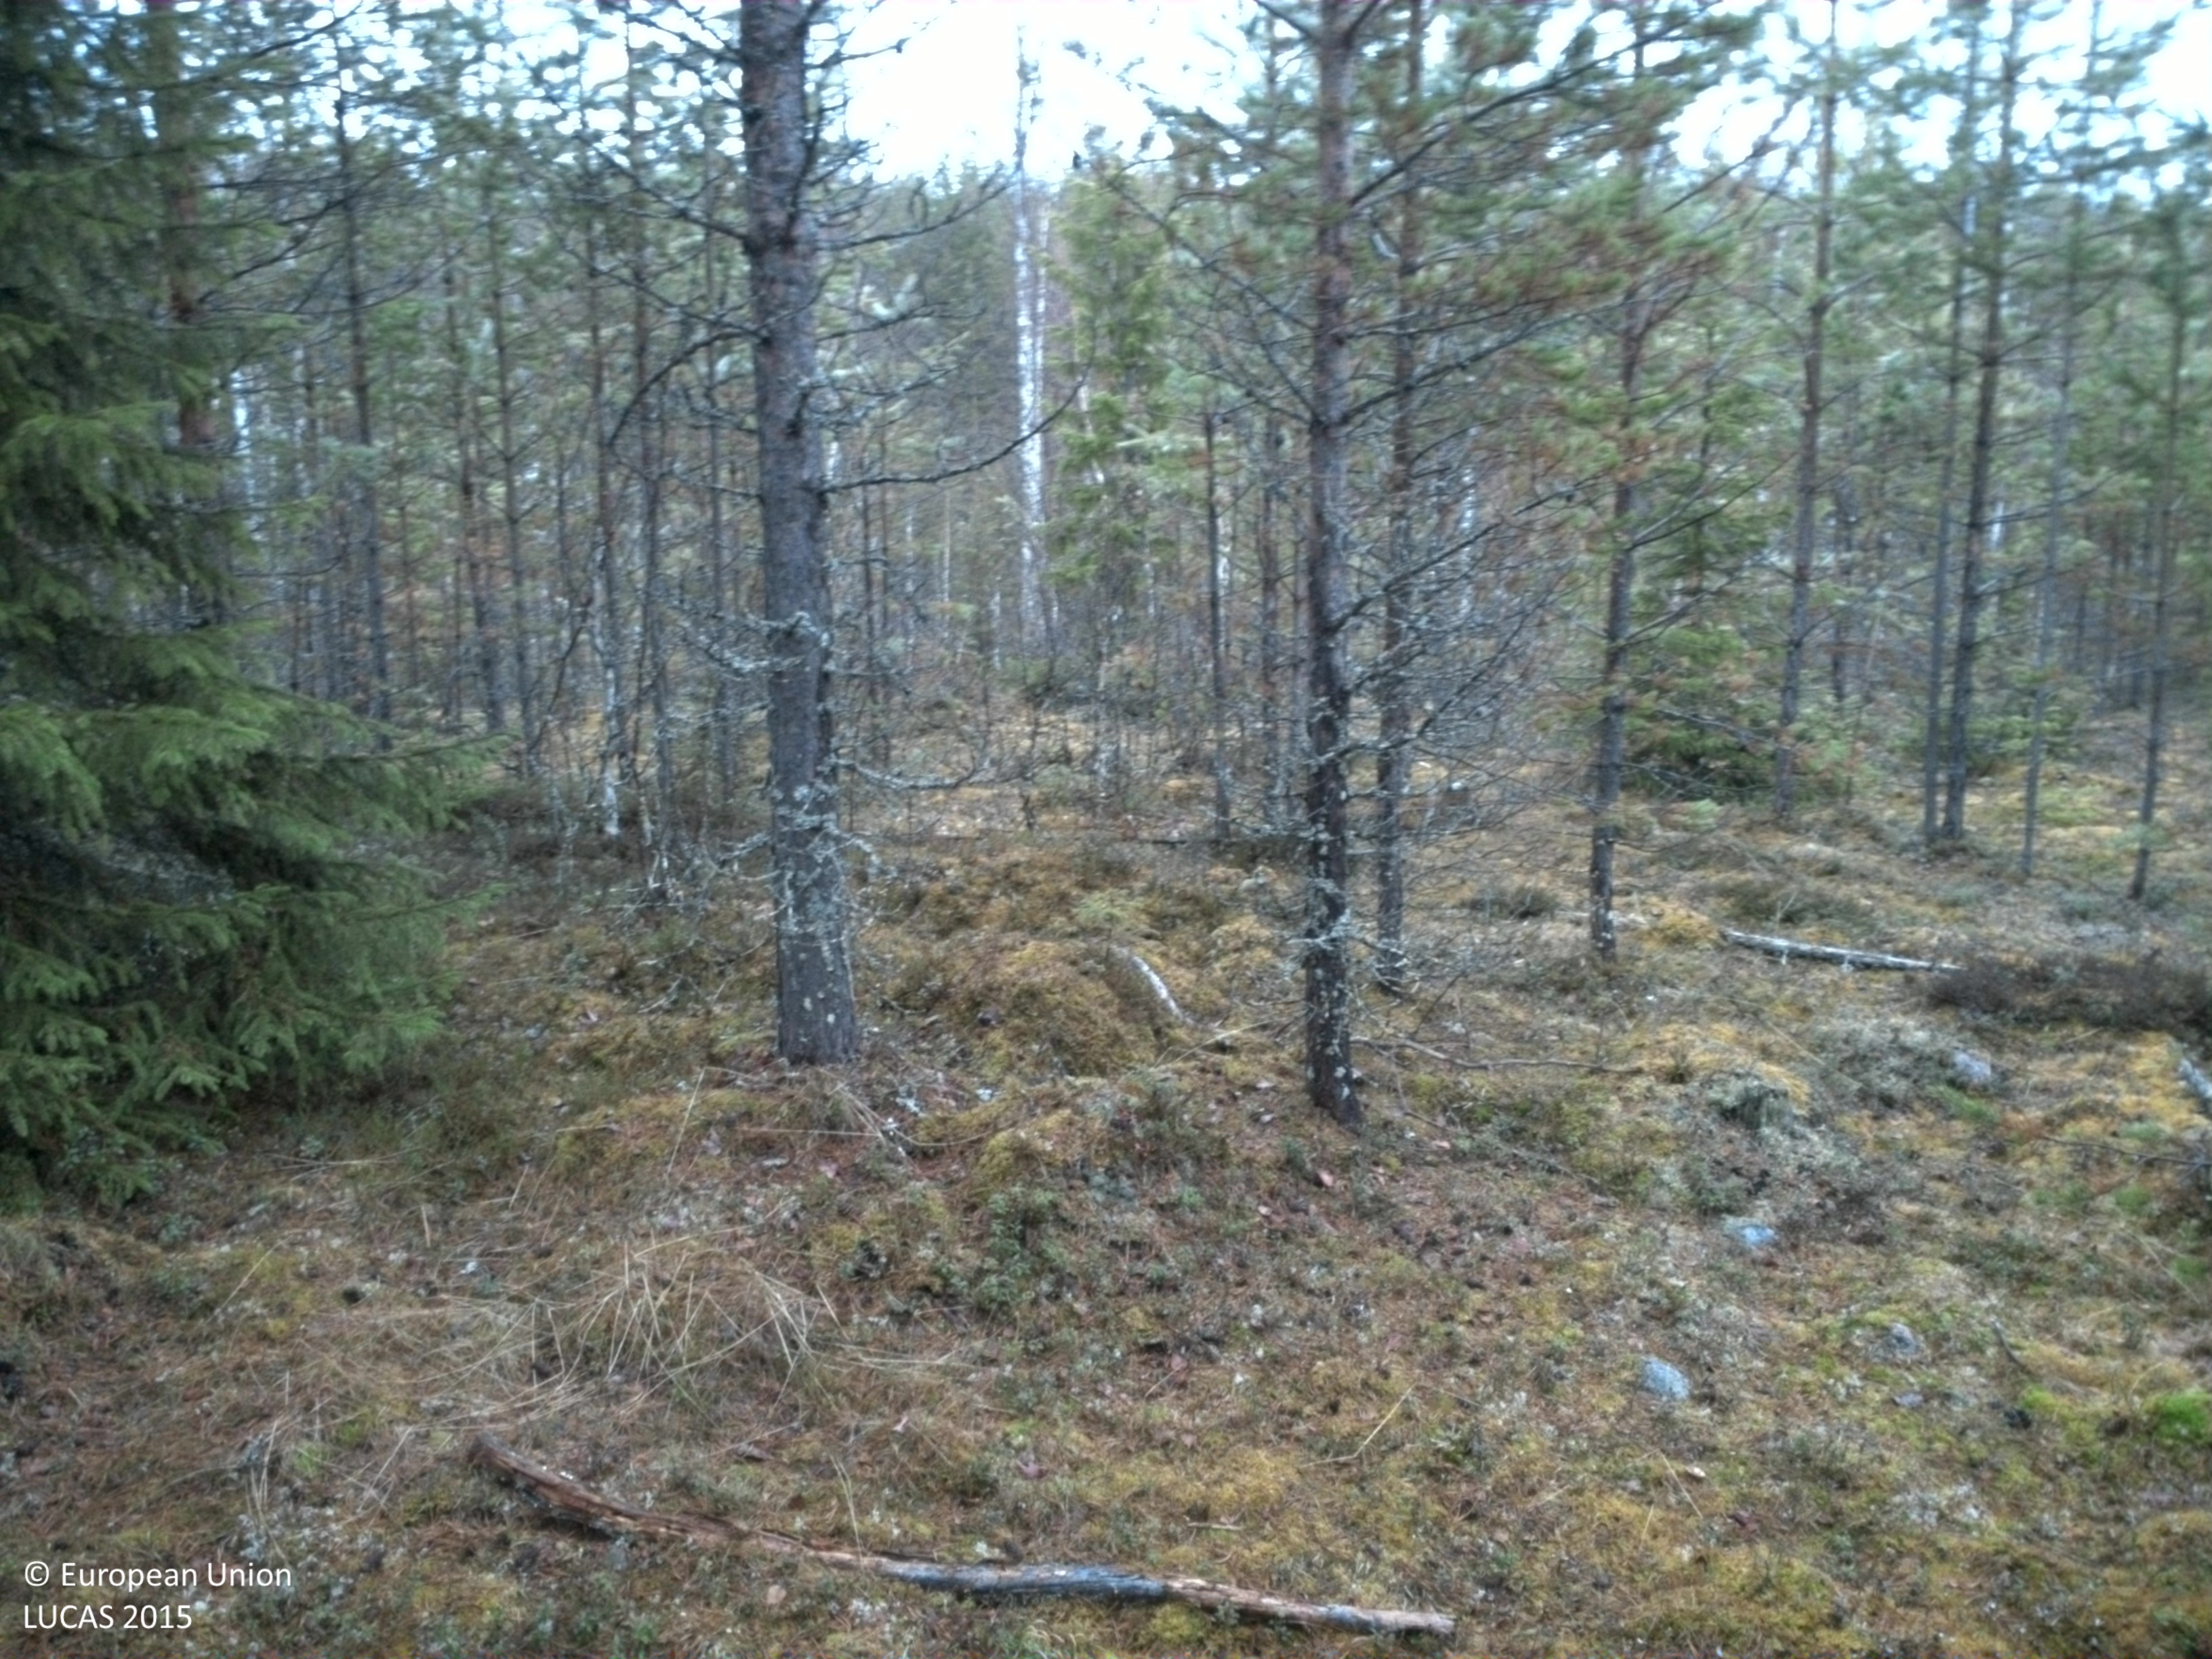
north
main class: Woodland
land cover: Pine dominated coniferous woodland
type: boreal forest
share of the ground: 50 - 75 %
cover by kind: coniferous forest trees 60 %, lichens and mosses 25 %, shrubs 15 %
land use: Forestry
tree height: > 5 m
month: May
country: SE
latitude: 65.9244
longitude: 22.9236
